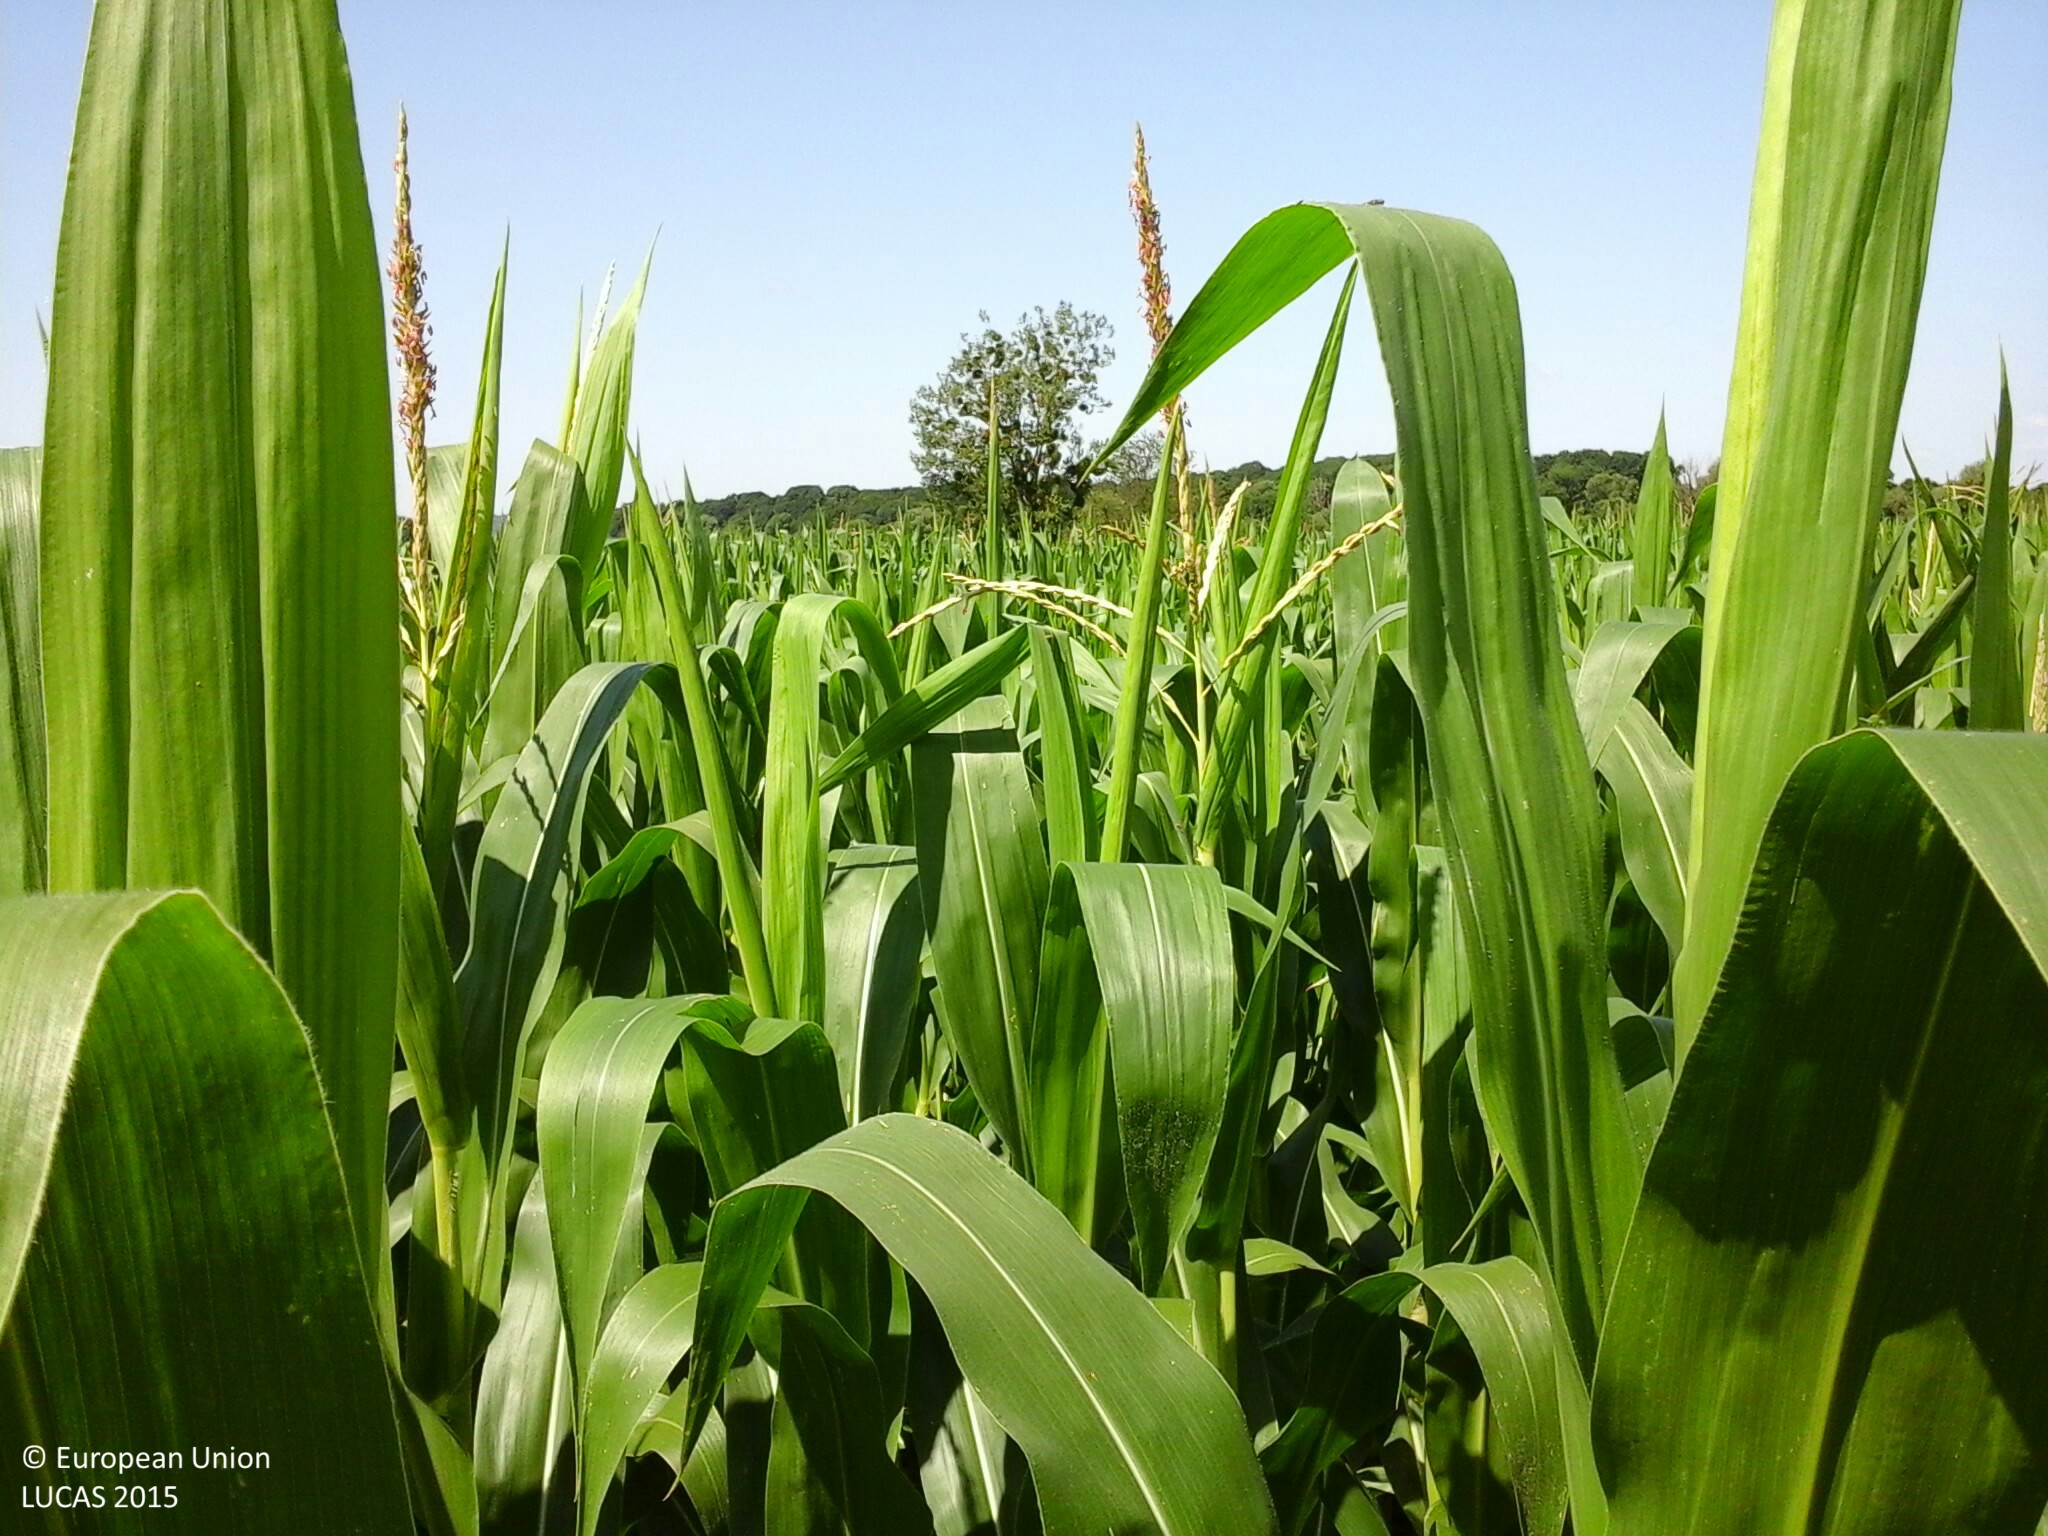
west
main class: Cropland
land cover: Maize
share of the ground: > 75 %
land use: Agriculture (excluding fallow land and kitchen gardens)
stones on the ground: < 10 %
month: July
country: HU
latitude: 46.5978
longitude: 16.6200
